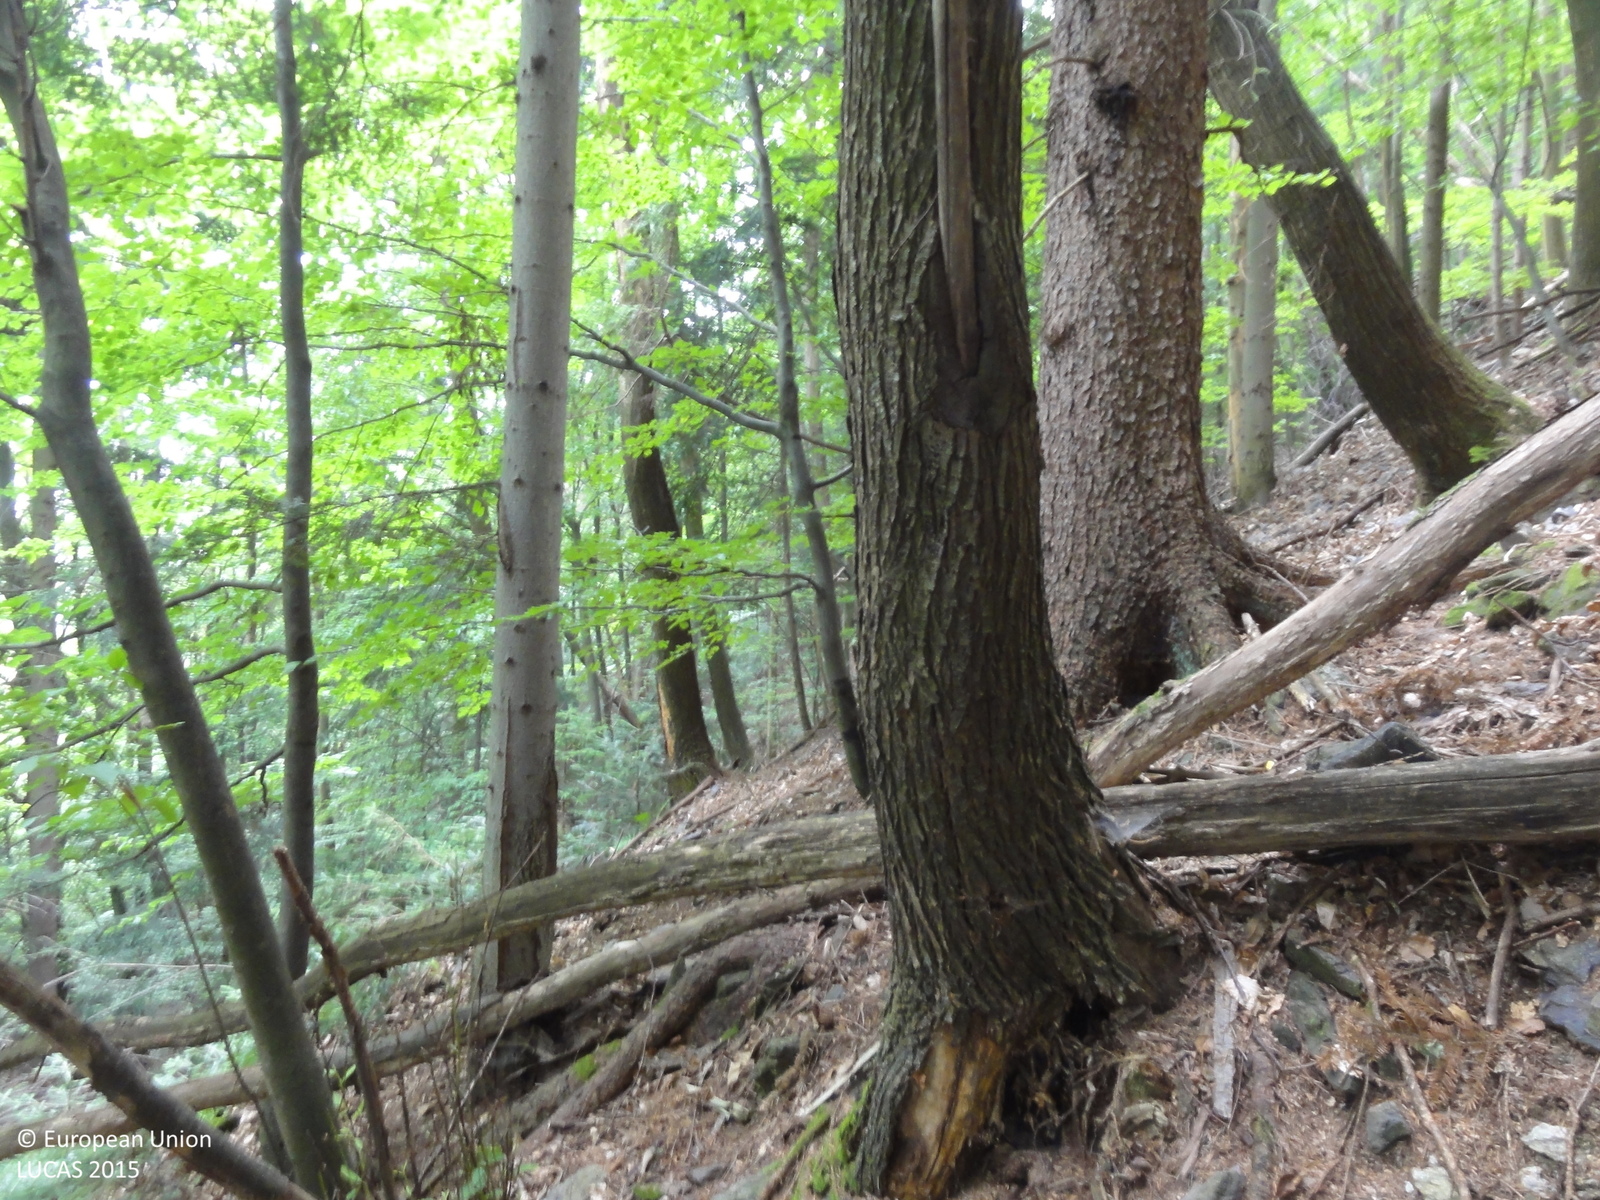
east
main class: Woodland
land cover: Spruce dominated mixed woodland
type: beech forest
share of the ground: > 75 %
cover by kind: broadleaved forest trees 60 %, coniferous forest trees 40 %
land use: Forestry
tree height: > 5 m
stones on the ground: 25 - 50 %
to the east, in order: Spruce dominated mixed woodland; Tracks; Spruce dominated mixed woodland; Tracks; Spruce dominated mixed woodland
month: July
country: SI
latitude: 46.6030
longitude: 15.5735
